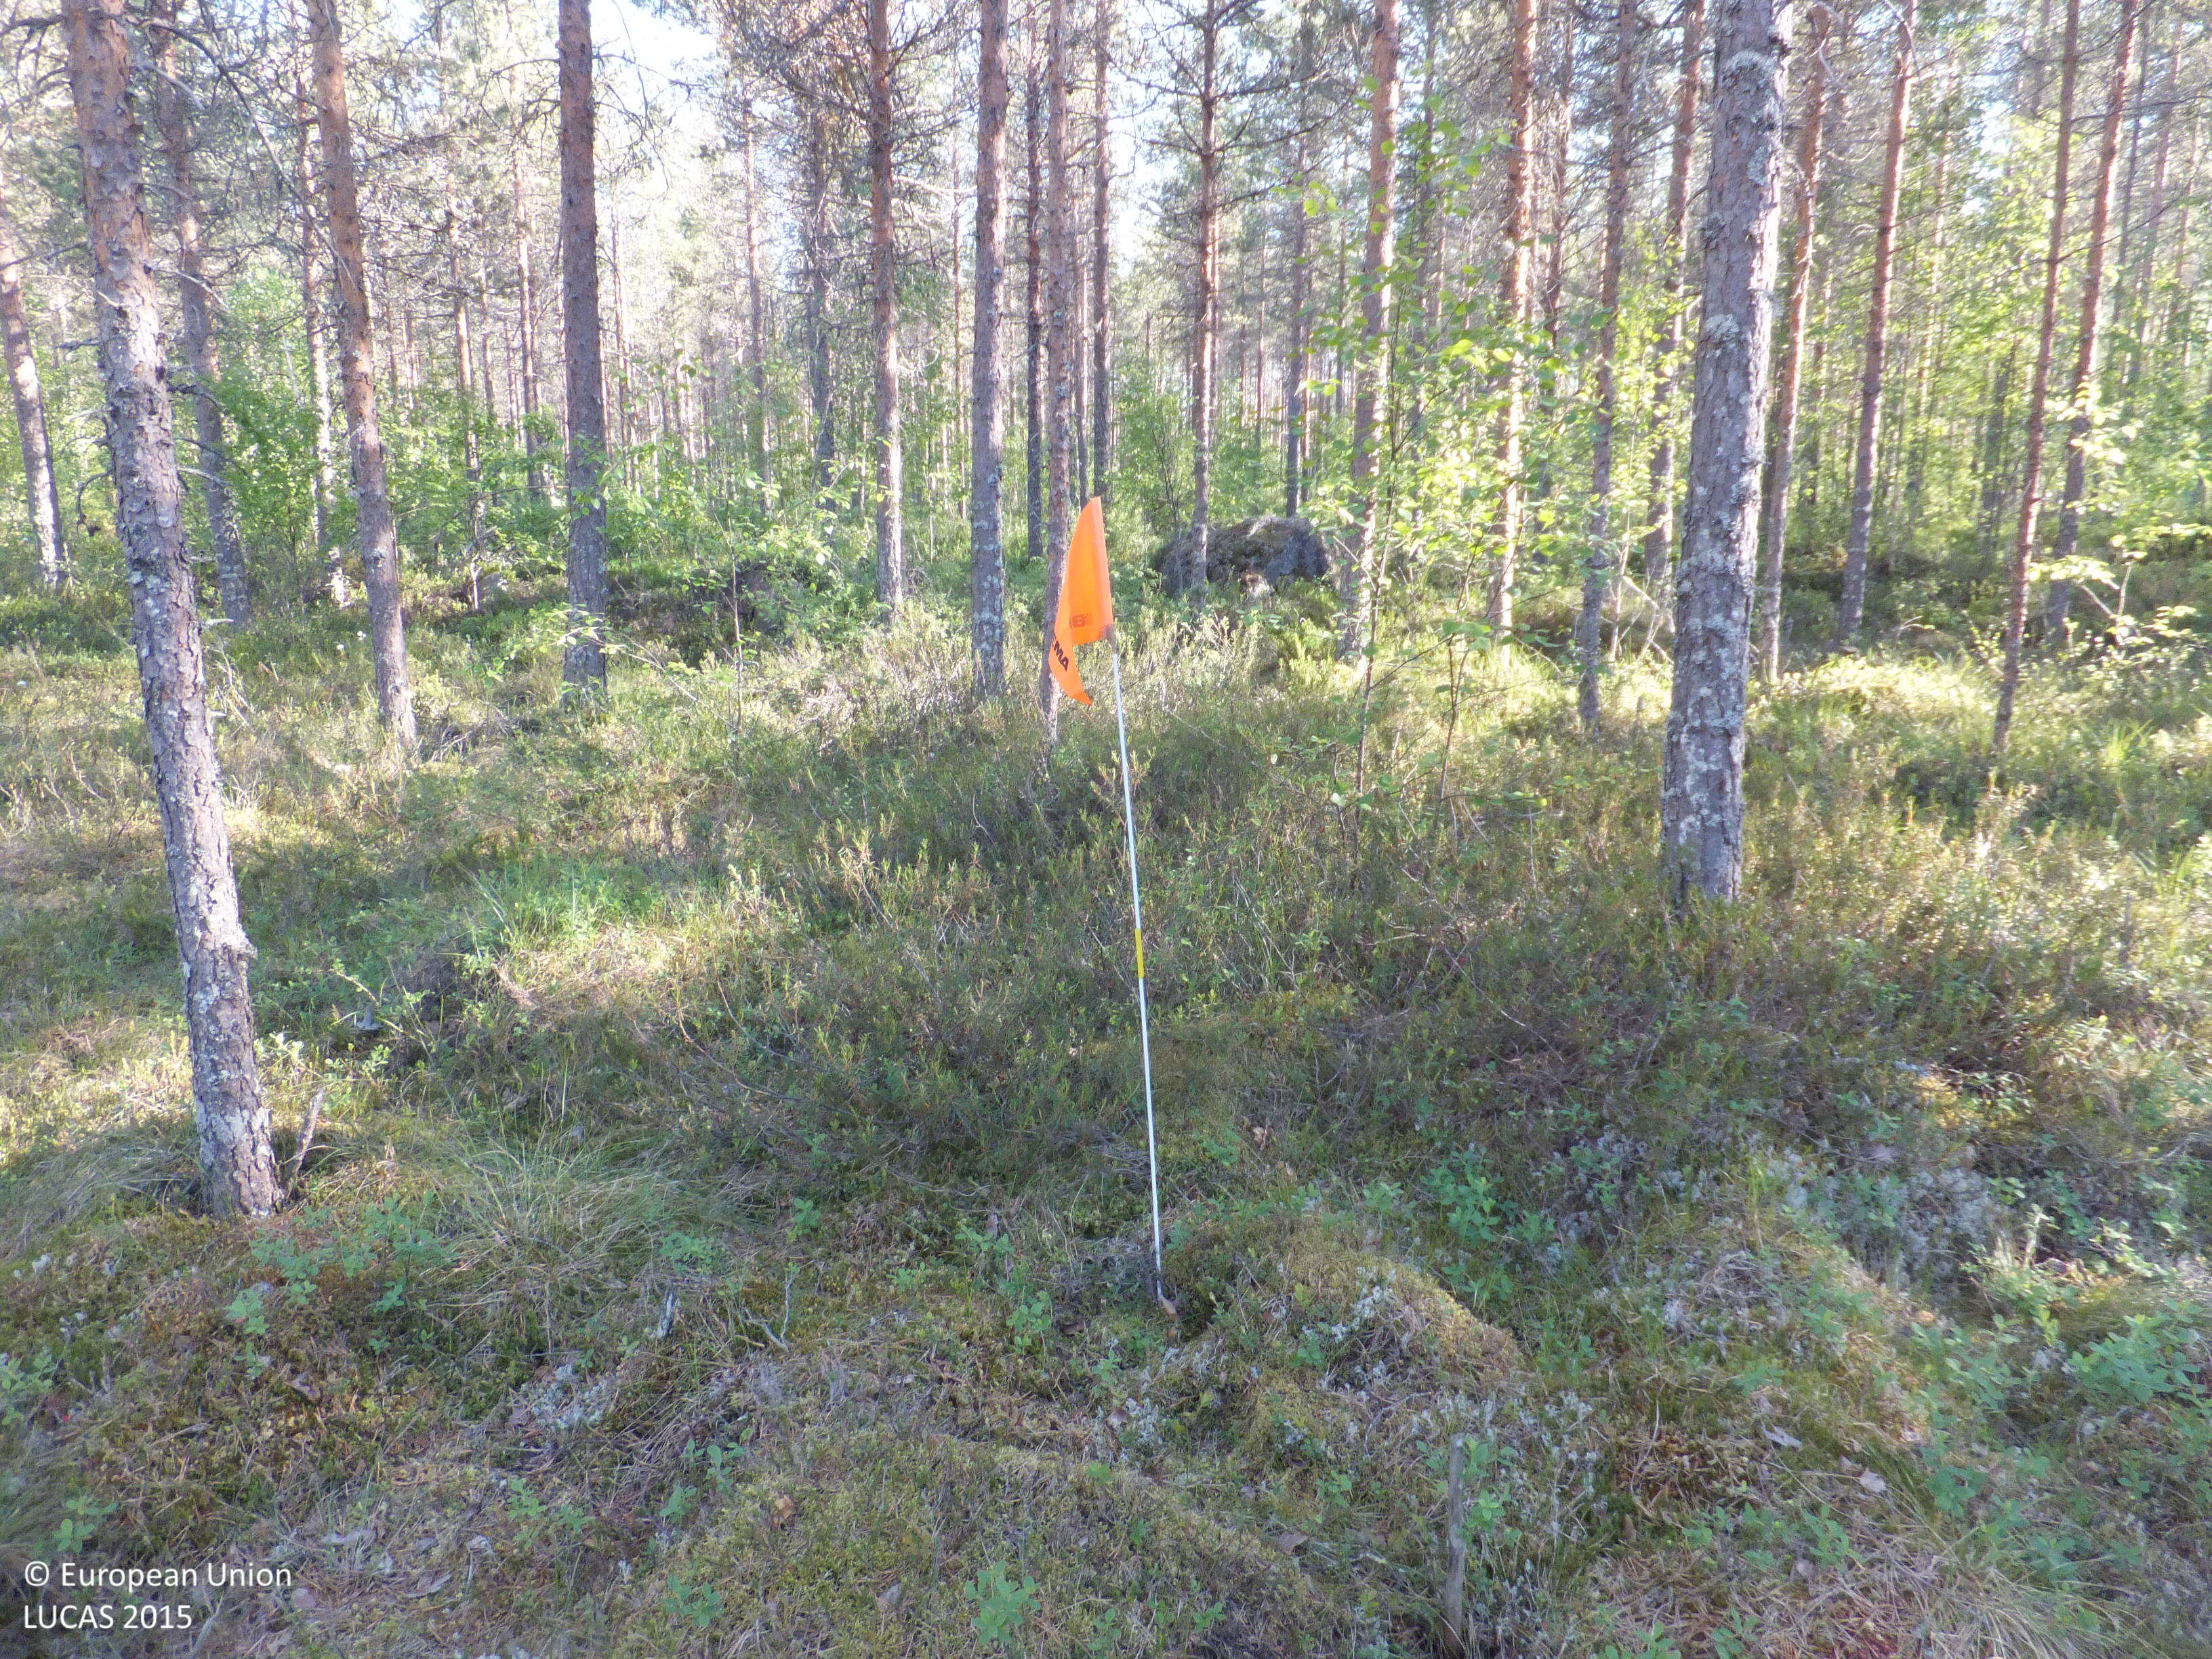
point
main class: Woodland
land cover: Pine dominated coniferous woodland
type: boreal forest
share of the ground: > 75 %
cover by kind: coniferous forest trees 80 %, broadleaved forest trees 5 %, shrubs 5 %, lichens and mosses 5 %, unconsolidated bare surface 5 %
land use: Forestry
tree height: > 5 m
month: June
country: FI
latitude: 63.3288
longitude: 24.2342
